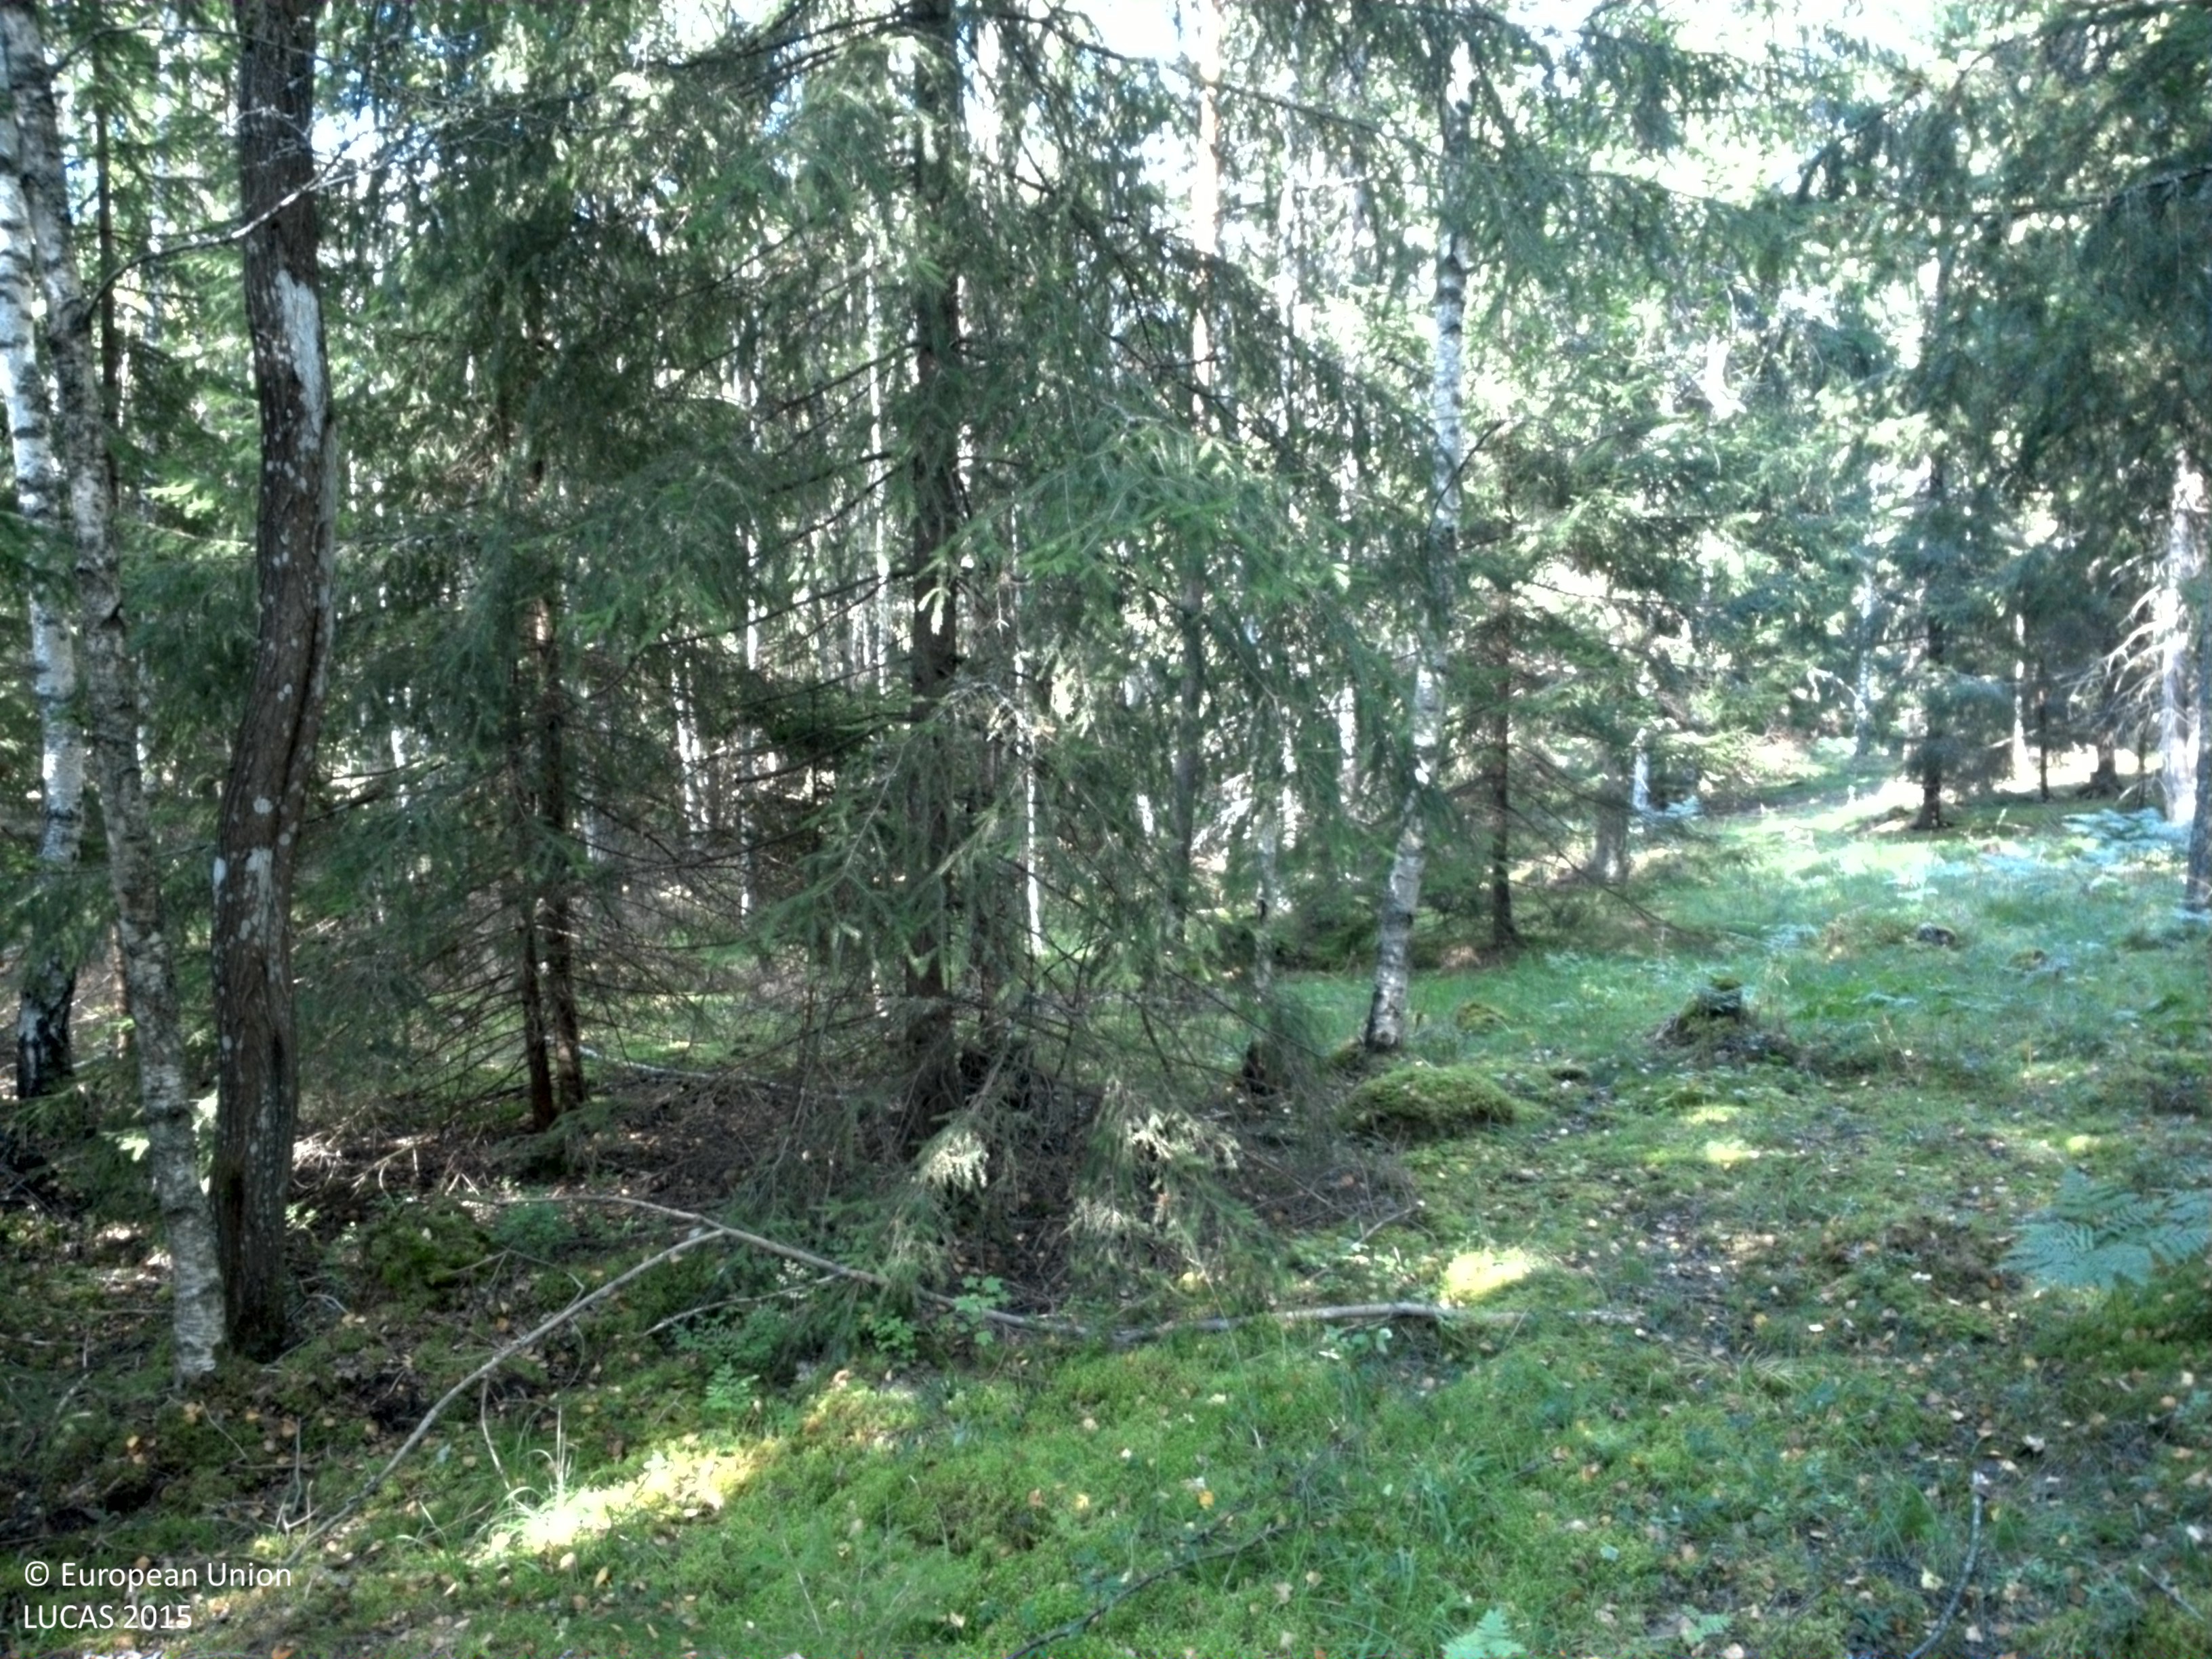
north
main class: Woodland
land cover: Spruce dominated mixed woodland
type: boreal forest
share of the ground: 50 - 75 %
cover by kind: coniferous forest trees 45 %, herbaceous plants 40 %, broadleaved forest trees 15 %
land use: Forestry
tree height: > 5 m
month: August
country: SE
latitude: 59.7078
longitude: 17.1918
